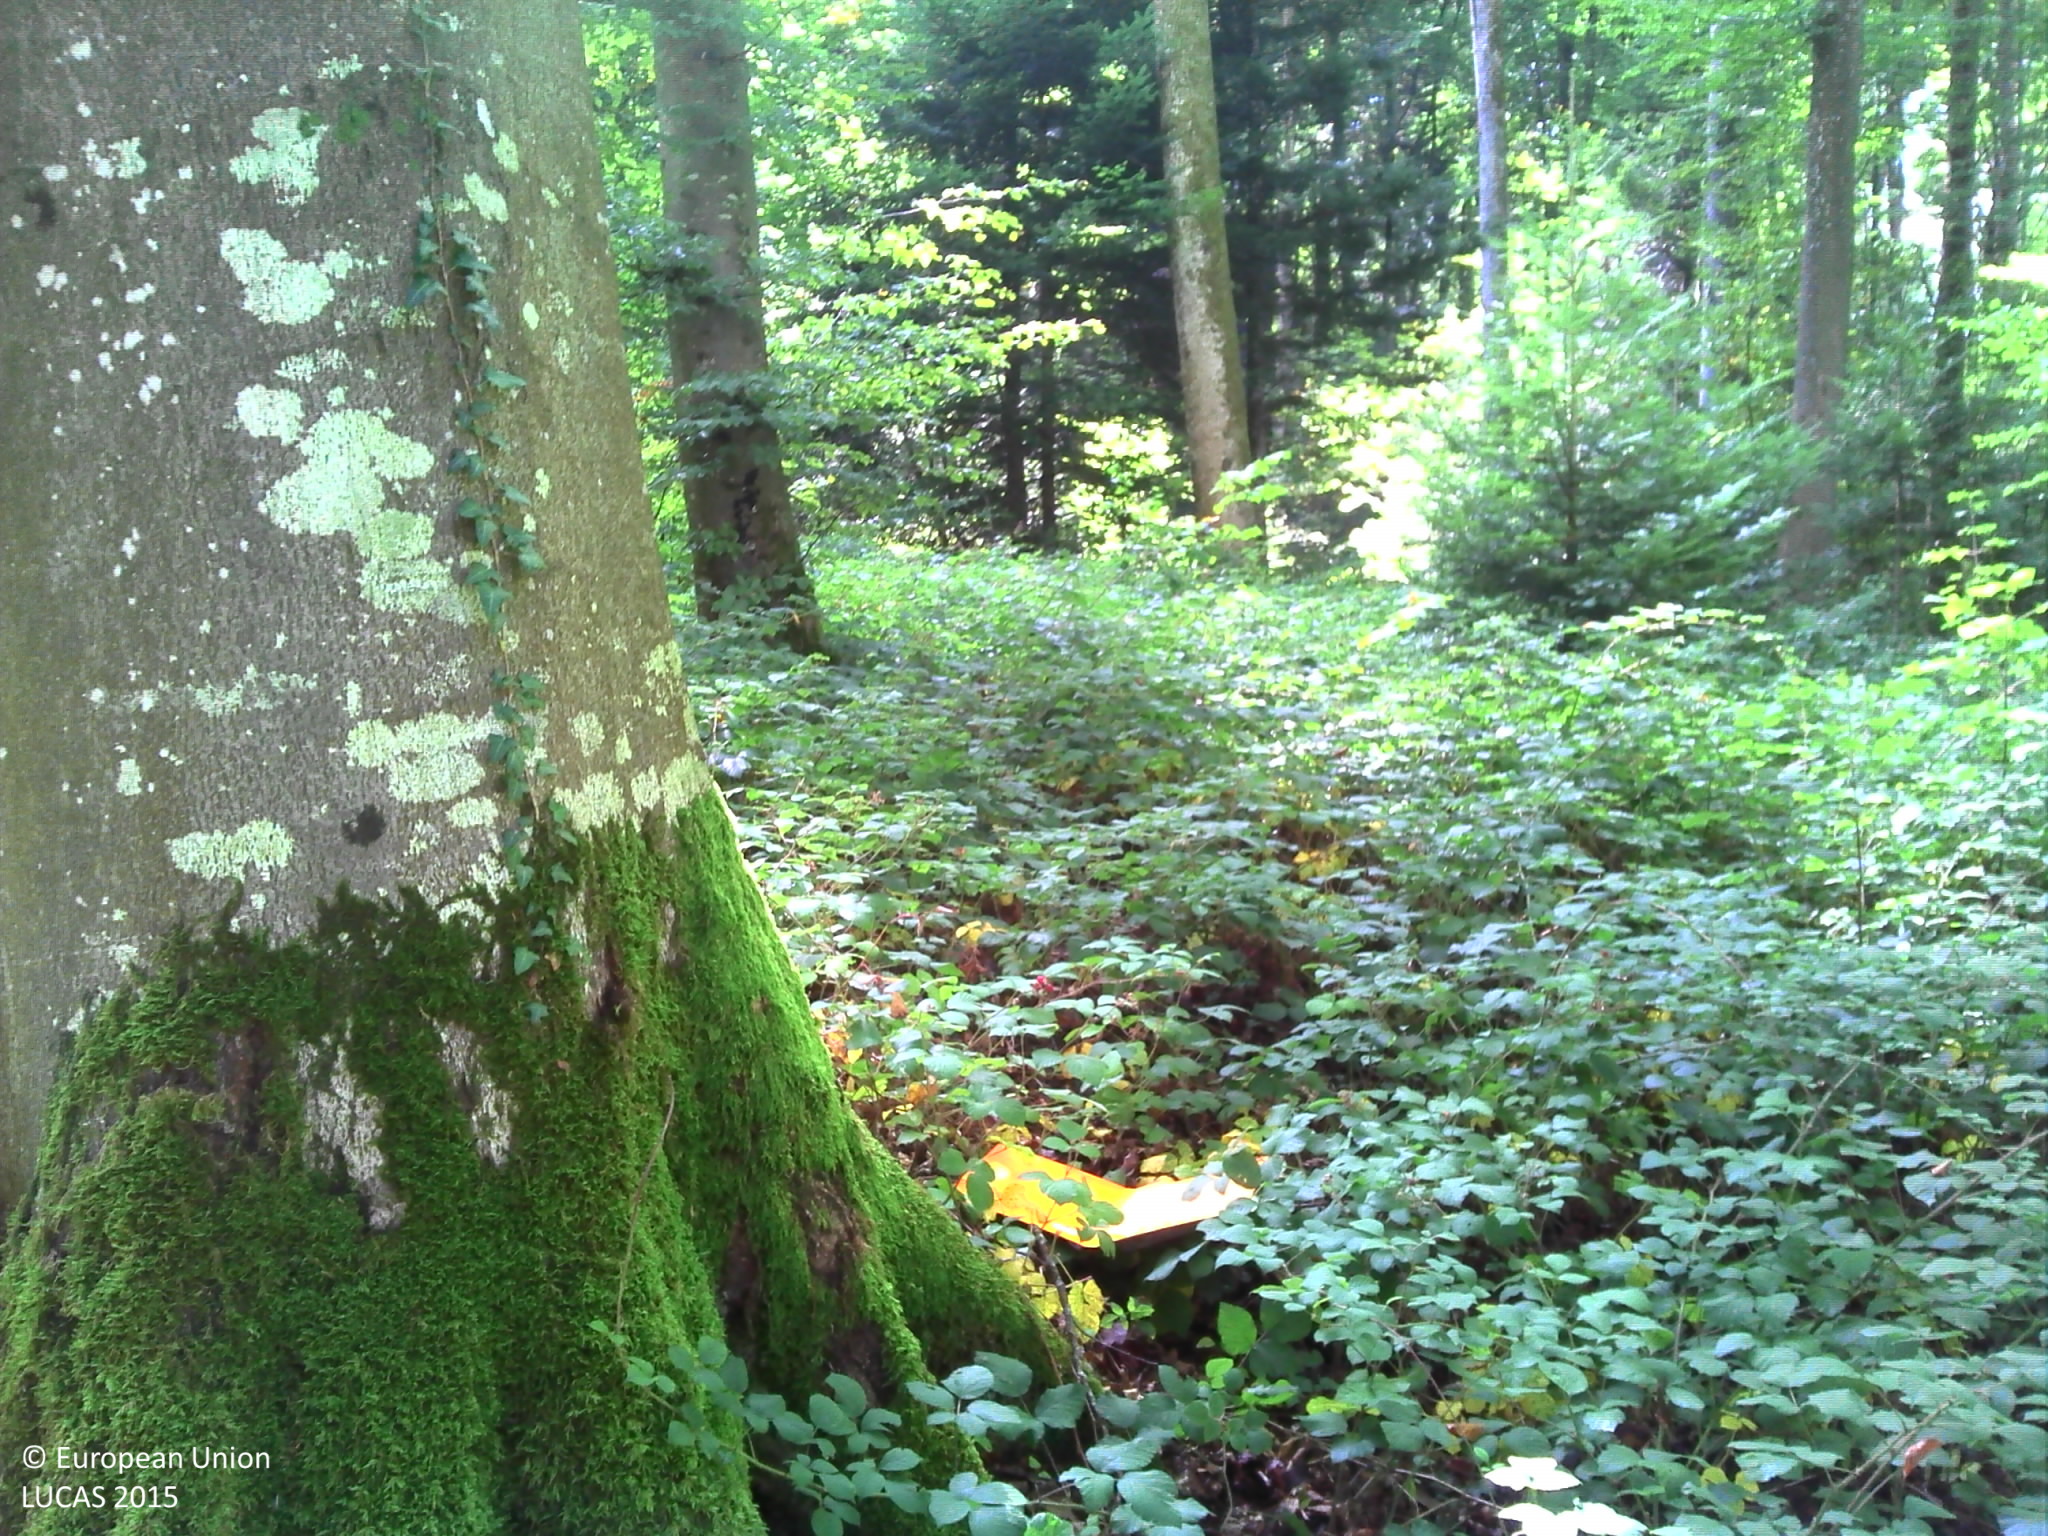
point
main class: Woodland
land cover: Broadleaved woodland
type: beech forest
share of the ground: > 75 %
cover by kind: broadleaved forest trees 80 %, shrubs 15 %, herbaceous plants 5 %
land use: Forestry
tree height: > 5 m
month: September
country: FR
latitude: 47.3684
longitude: 6.8635
